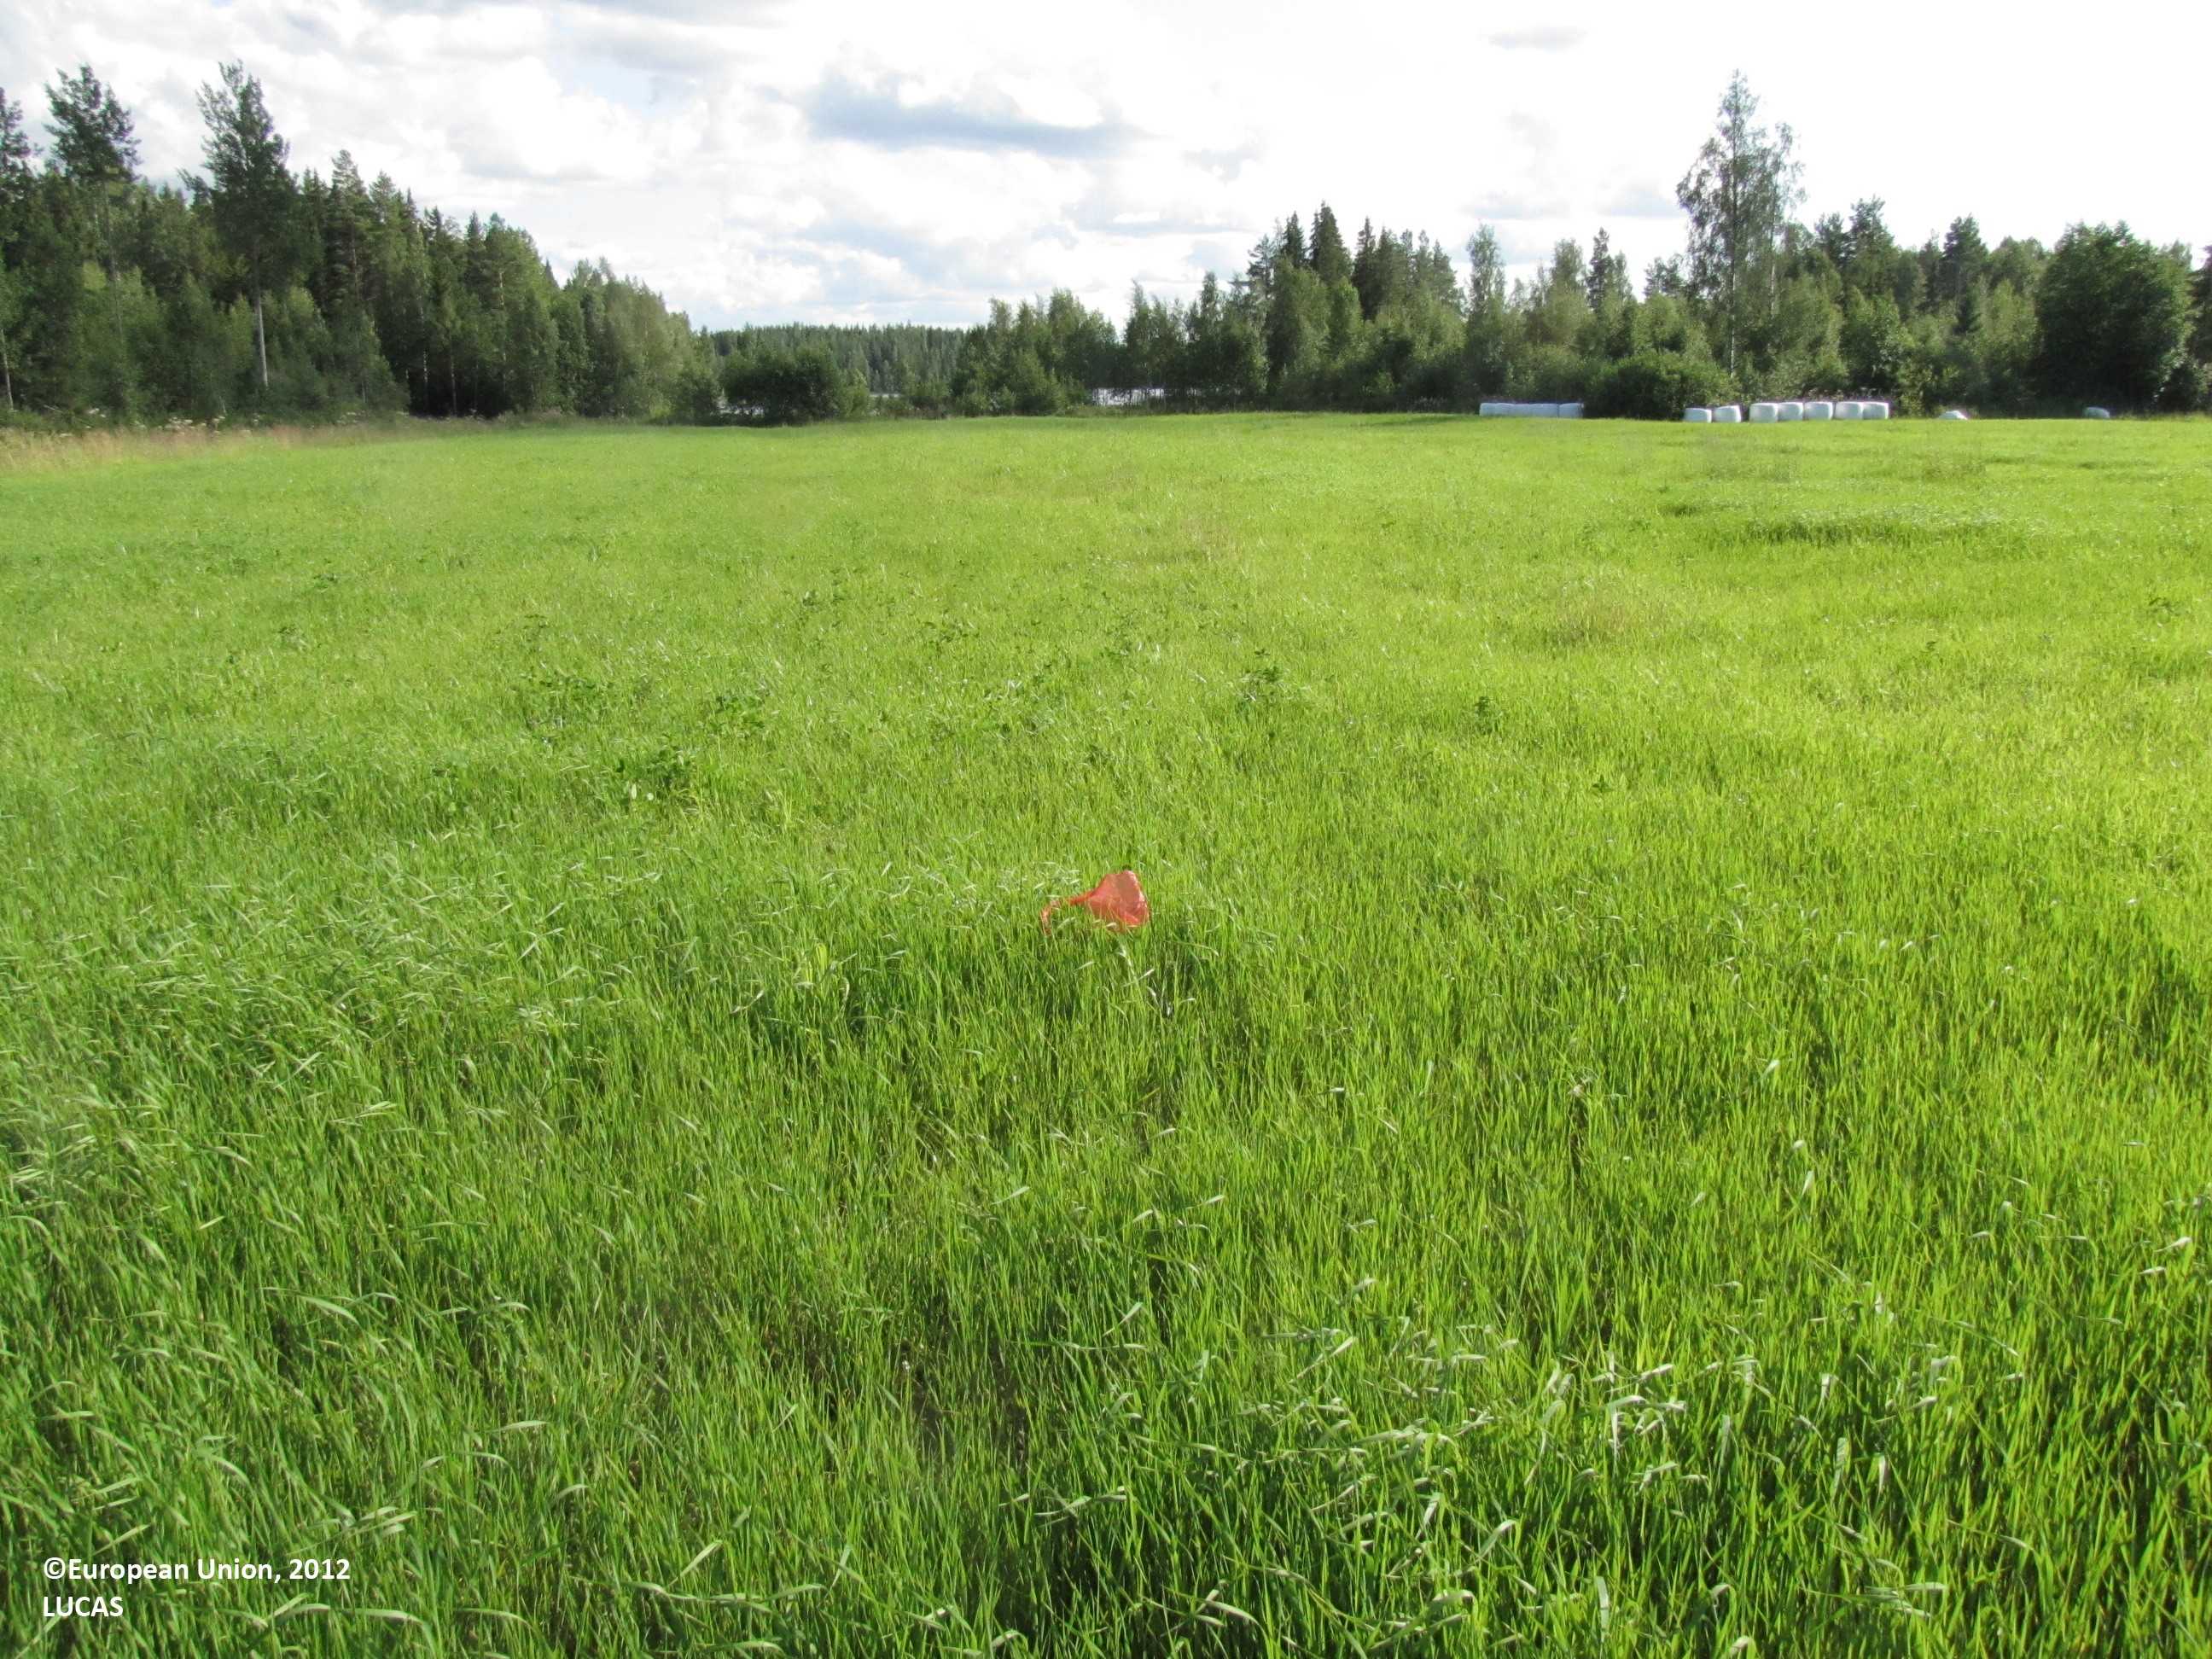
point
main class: Cropland
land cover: Temporary grasslands
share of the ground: > 75 %
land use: Agriculture (excluding fallow land and kitchen gardens)
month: July
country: FI
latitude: 62.1296
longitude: 23.0875
